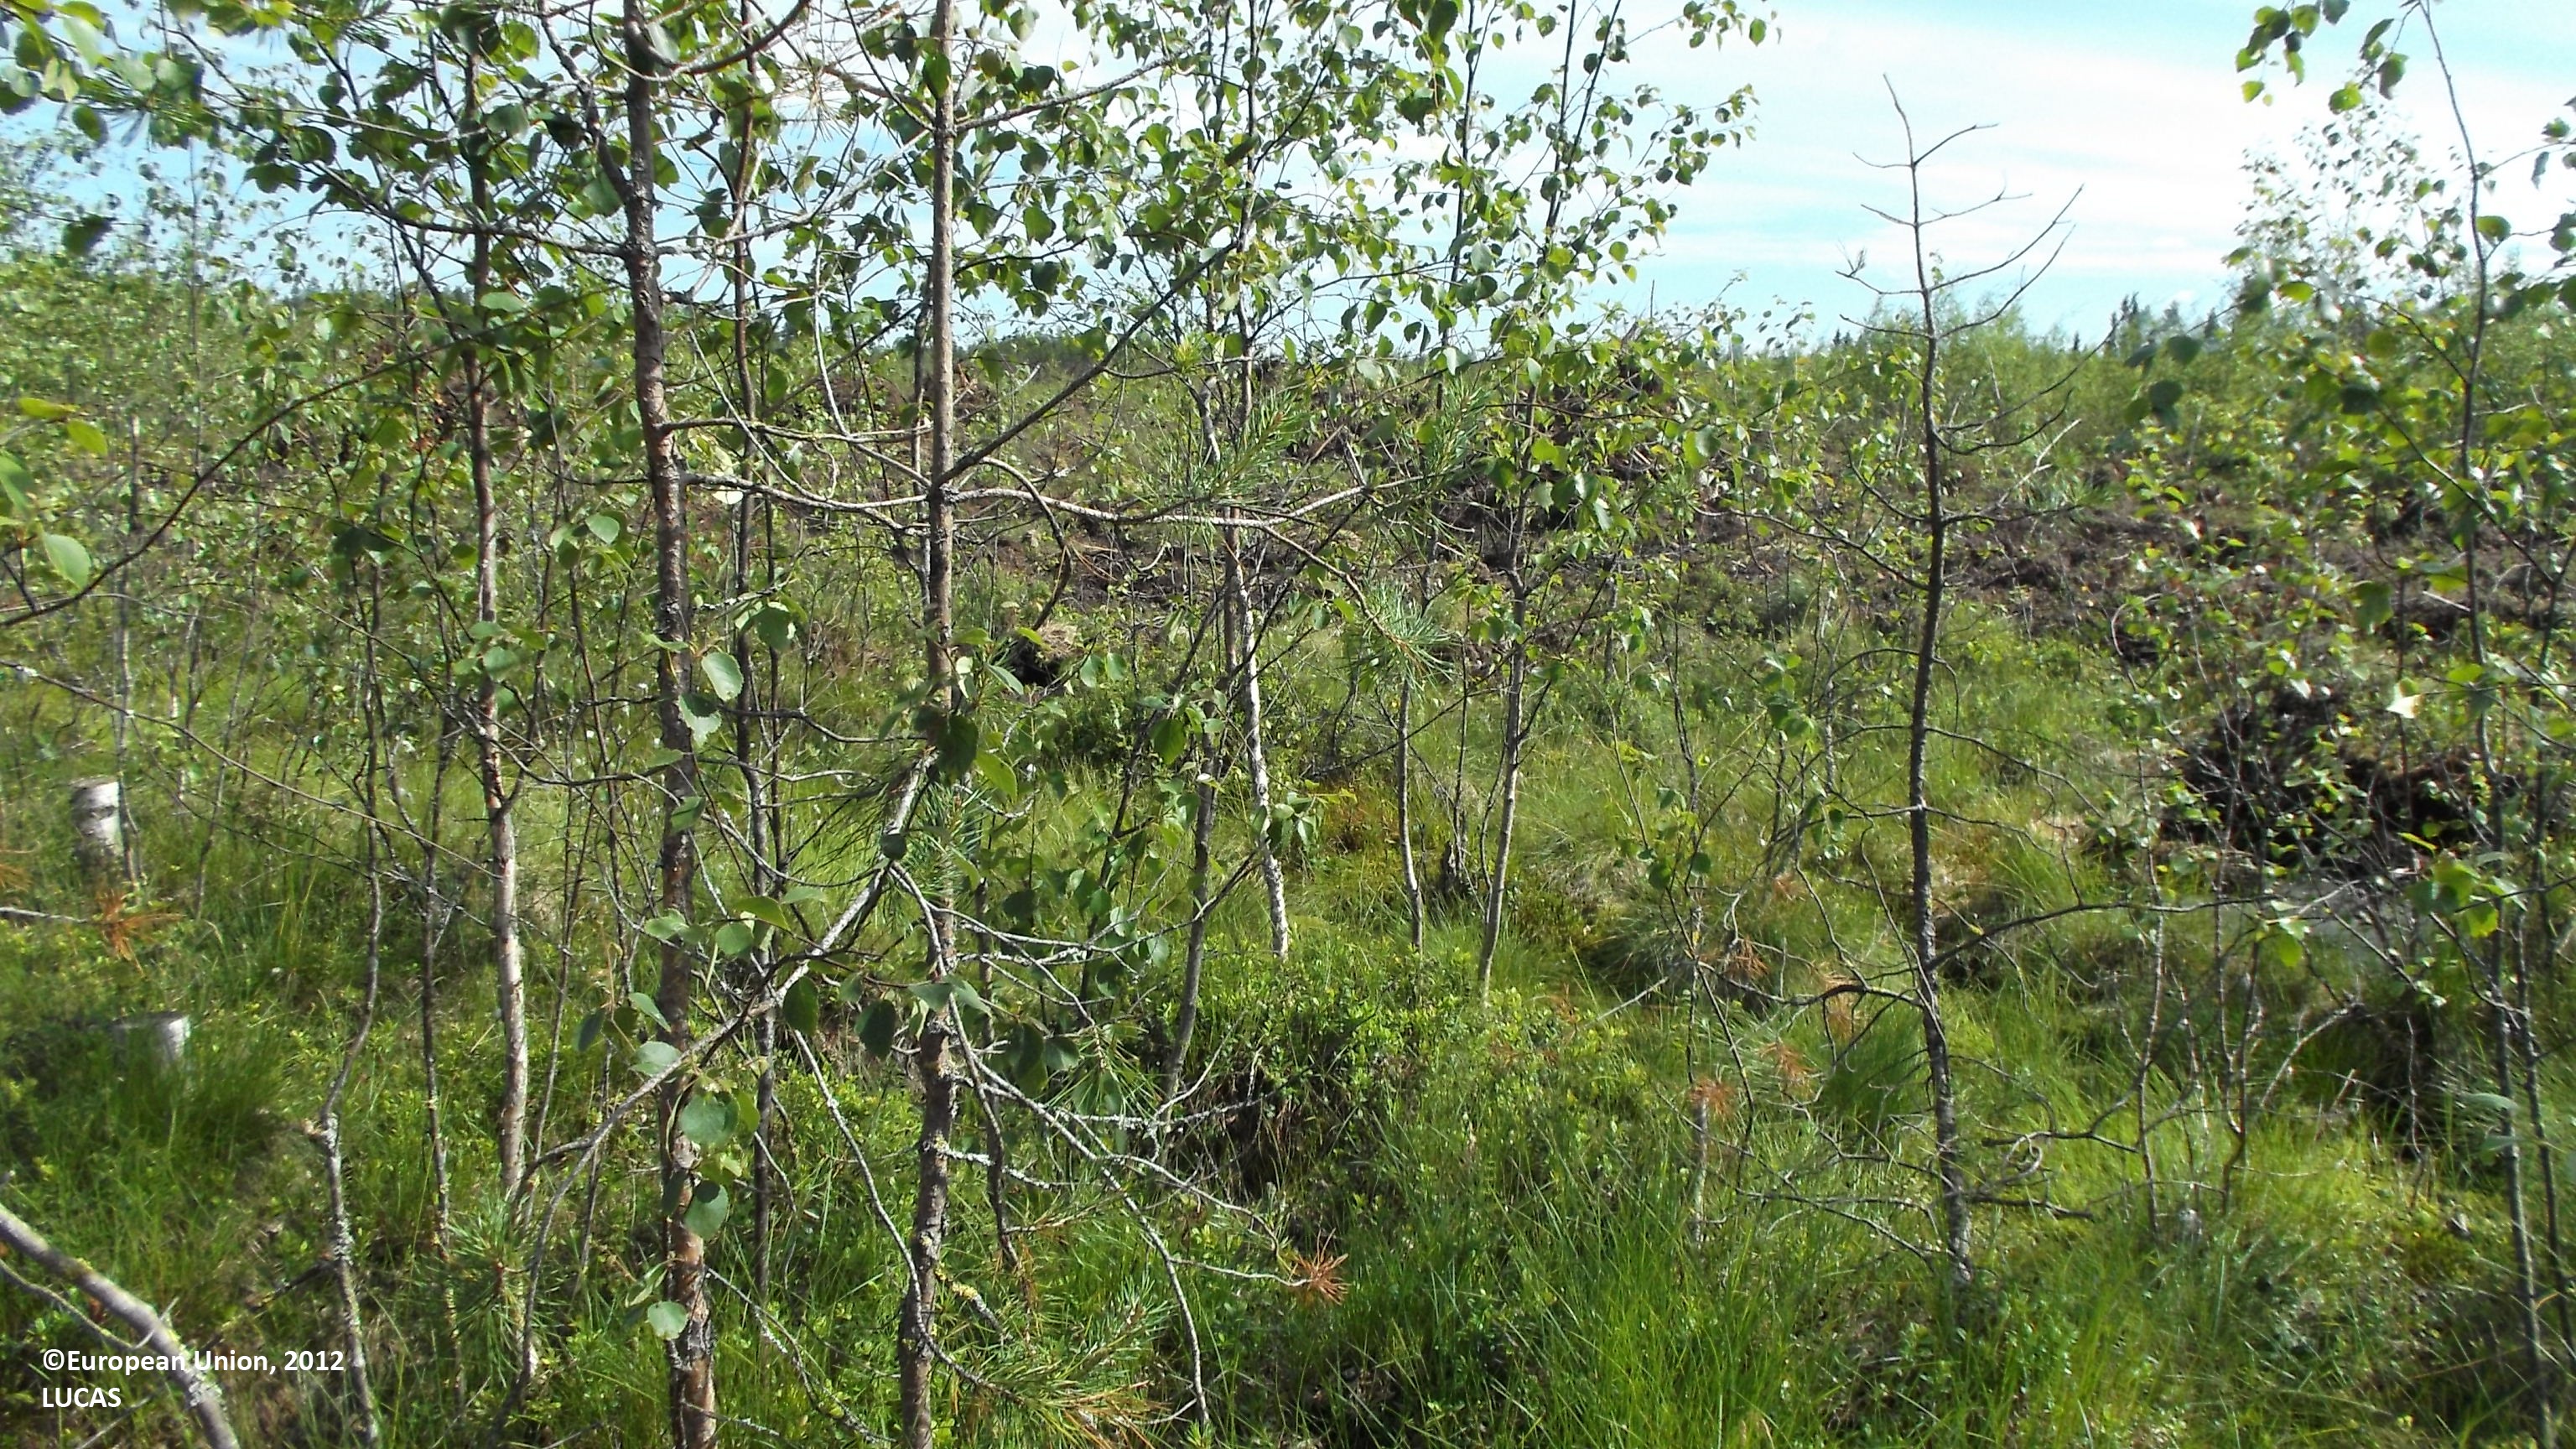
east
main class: Woodland
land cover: Broadleaved woodland
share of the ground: 10 - 25 %
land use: Forestry
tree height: < 5 m
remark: Clear cut
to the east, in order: Broadleaved woodland; Shrubland with sparse tree cover; Spontaneously vegetated surfaces; Abandoned hedges; Ditches and canals; Other bare soil; Spontaneously vegetated surfaces; Other bare soil; Spontaneously vegetated surfaces; Ditches and canals; Abandoned hedges; Other bare soil; Ditches and canals; Abandoned hedges; Other bare soil; Spontaneously vegetated surfaces; Ditches and canals; Spontaneously vegetated surfaces
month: July
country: FI
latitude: 63.5197
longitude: 23.9598
